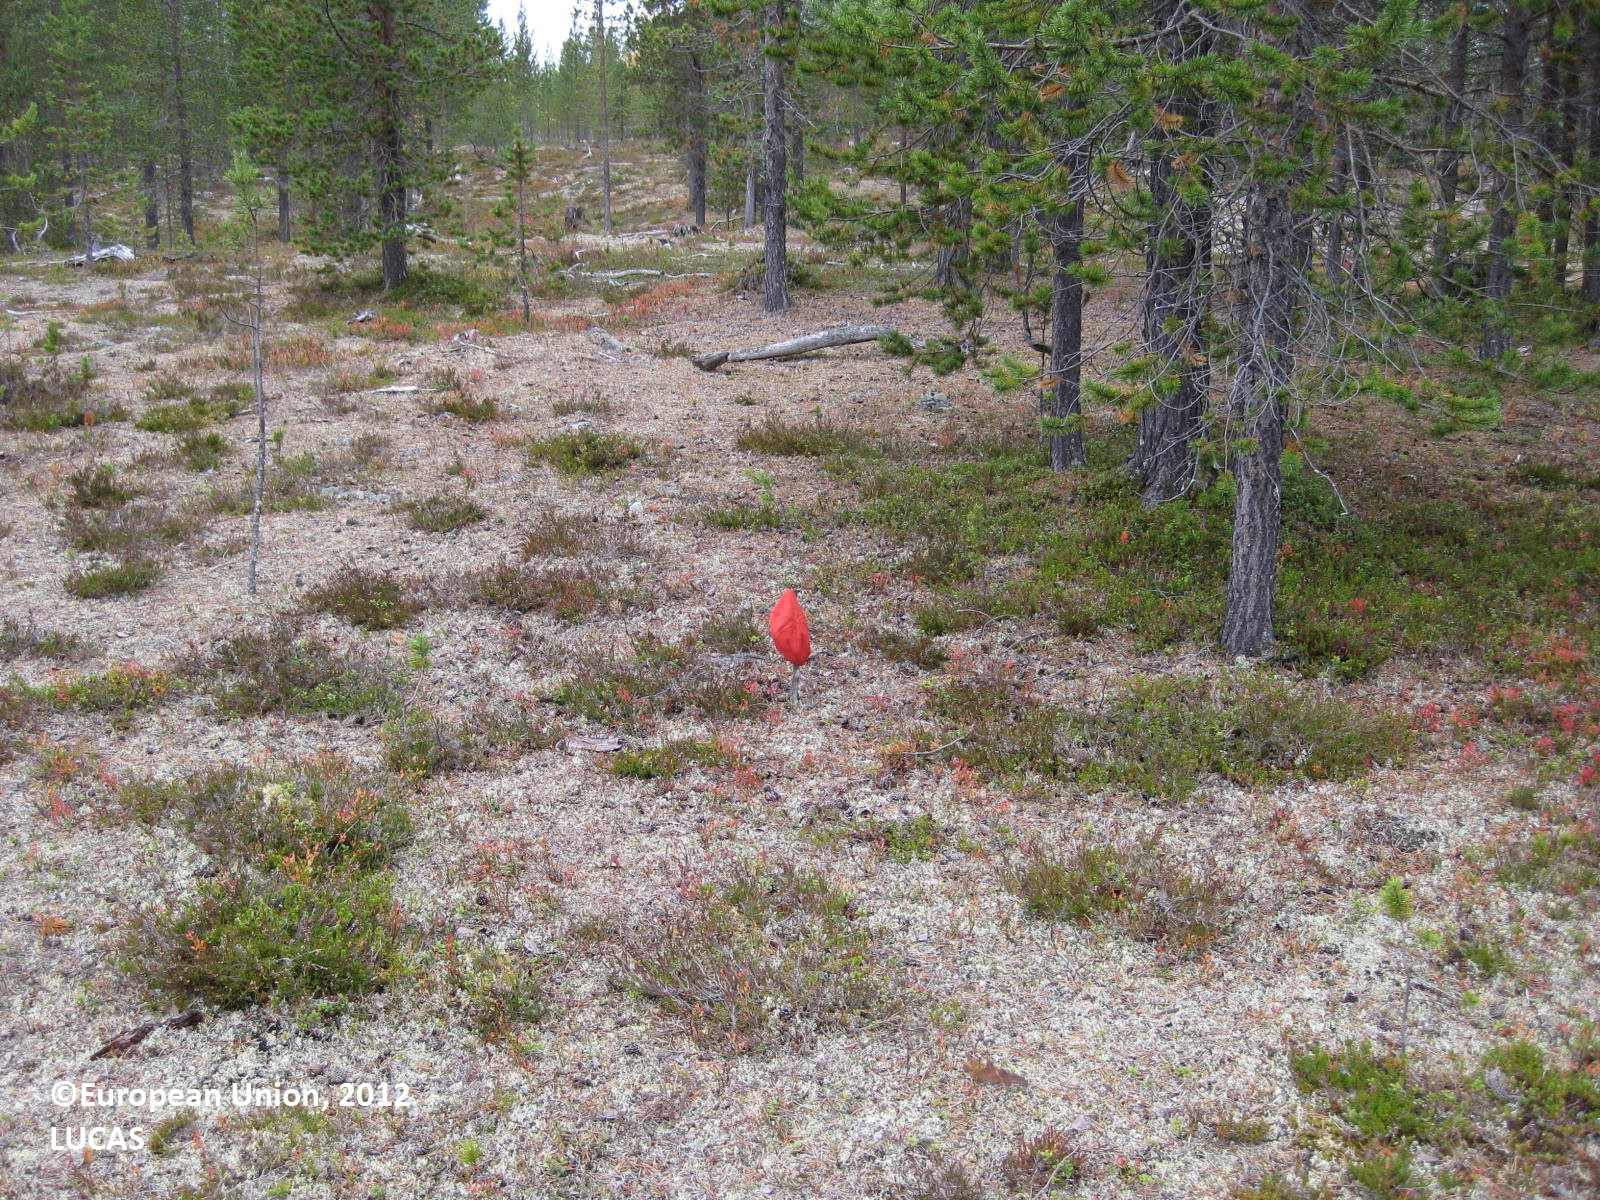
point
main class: Woodland
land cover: Pine dominated coniferous woodland
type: boreal forest
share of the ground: 50 - 75 %
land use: Forestry
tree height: > 5 m
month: September
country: FI
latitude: 68.0933
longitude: 23.7247
